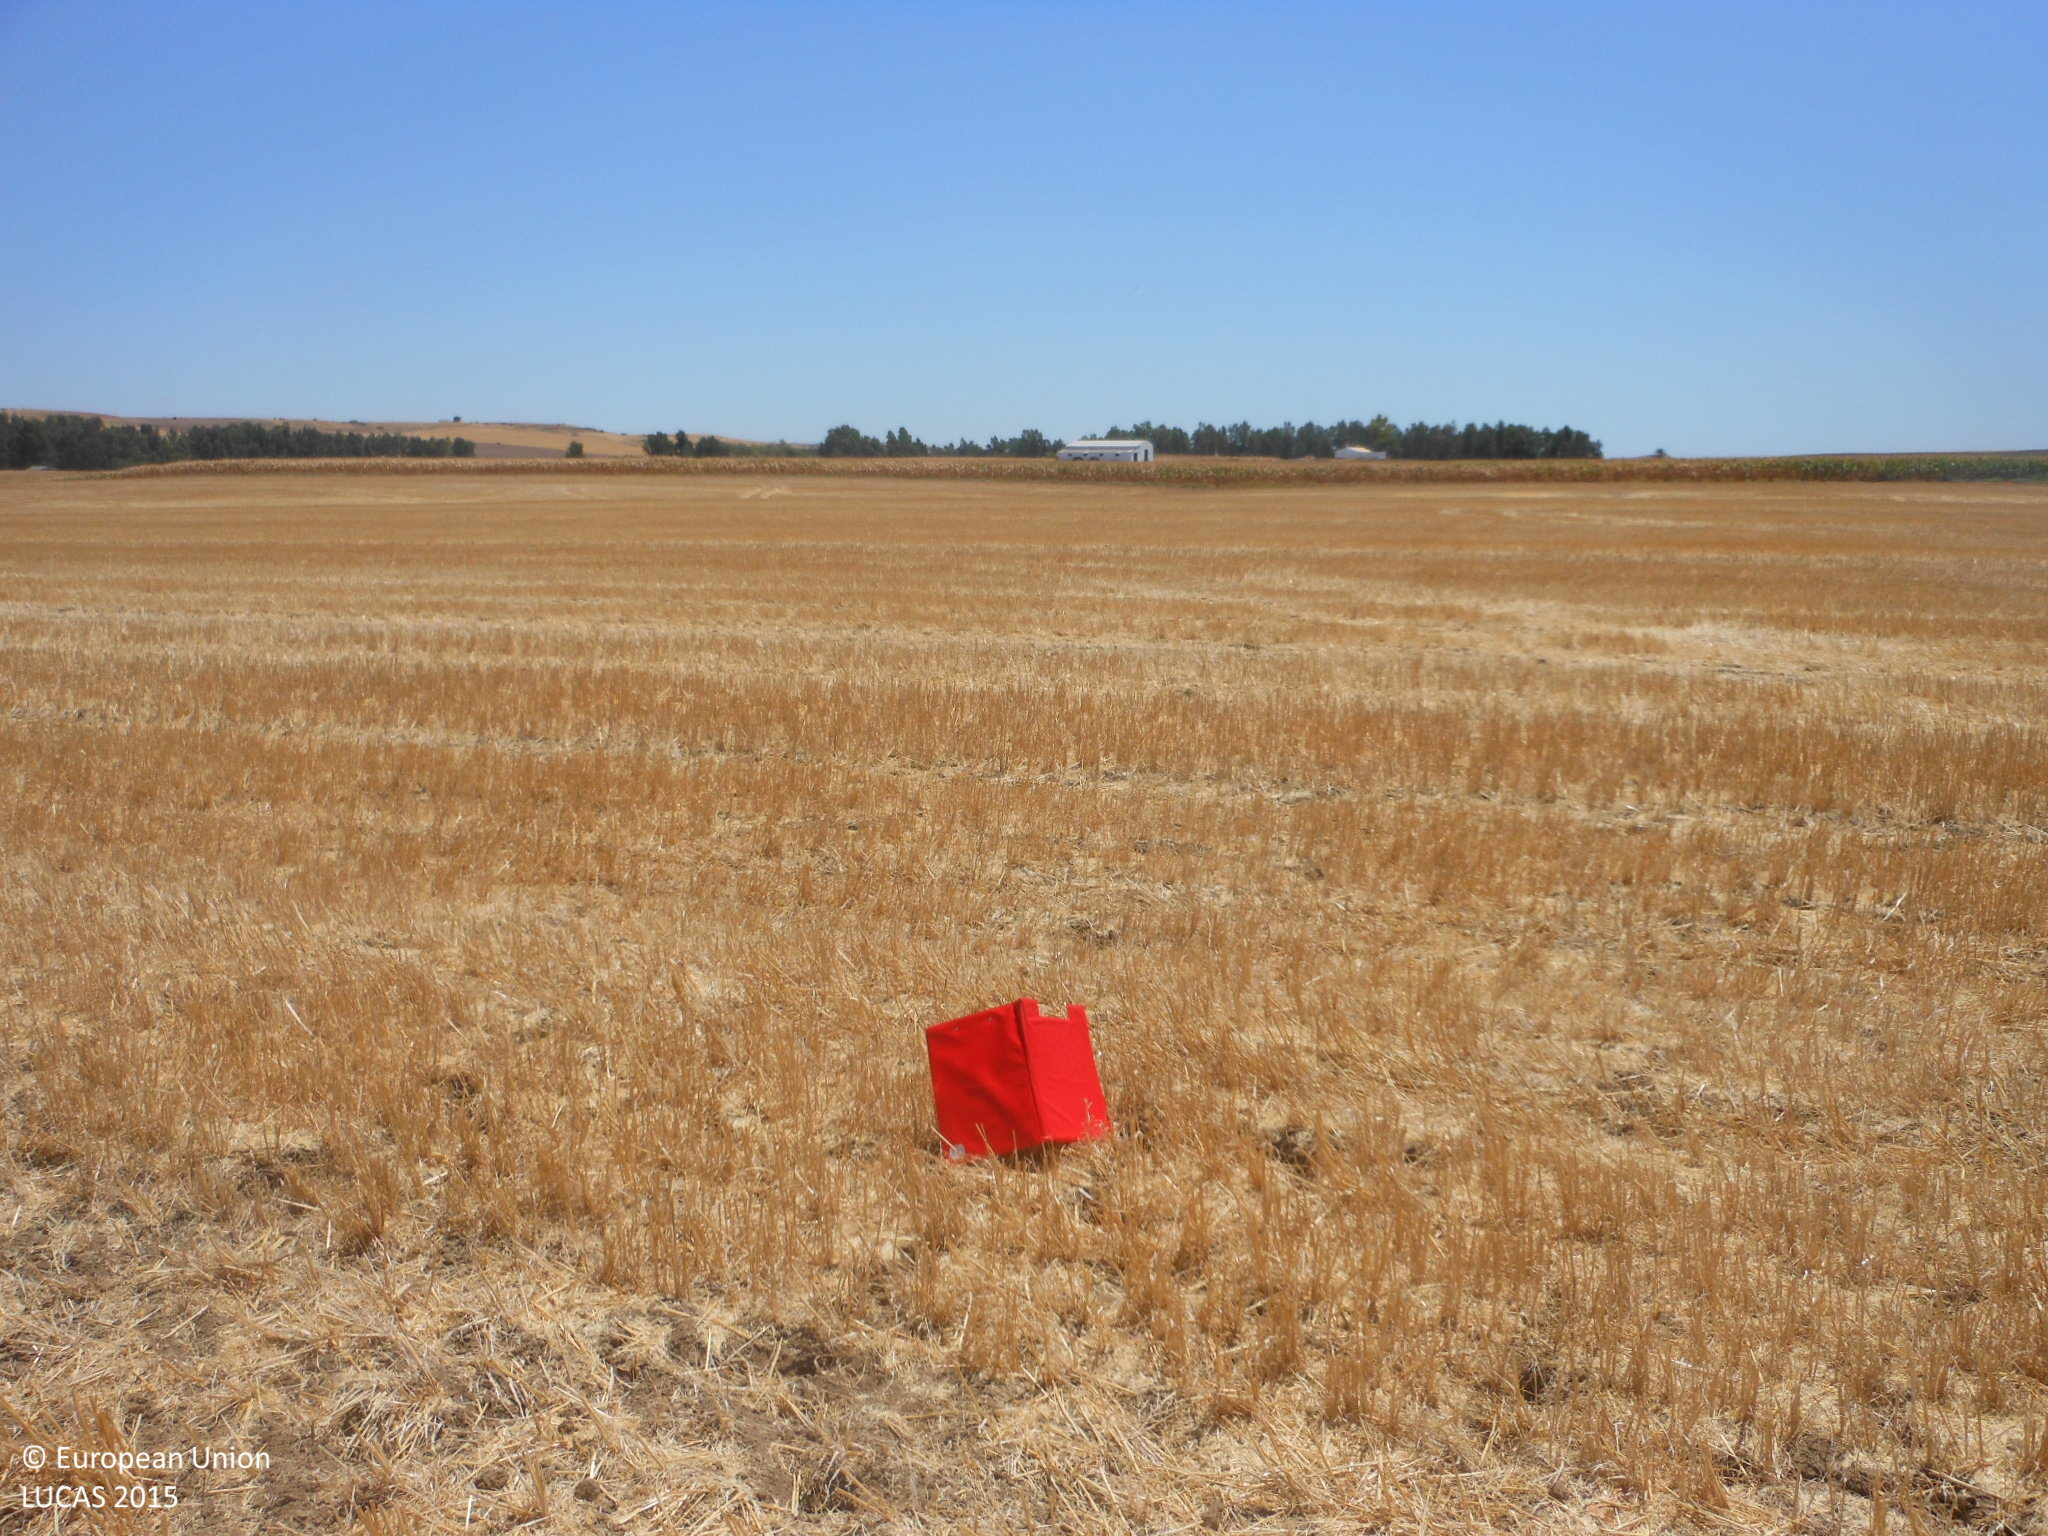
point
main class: Cropland
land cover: Barley
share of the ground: < 10 %
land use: Agriculture (excluding fallow land and kitchen gardens)
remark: Harvested field
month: July
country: ES
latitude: 37.5556
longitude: -5.6082
